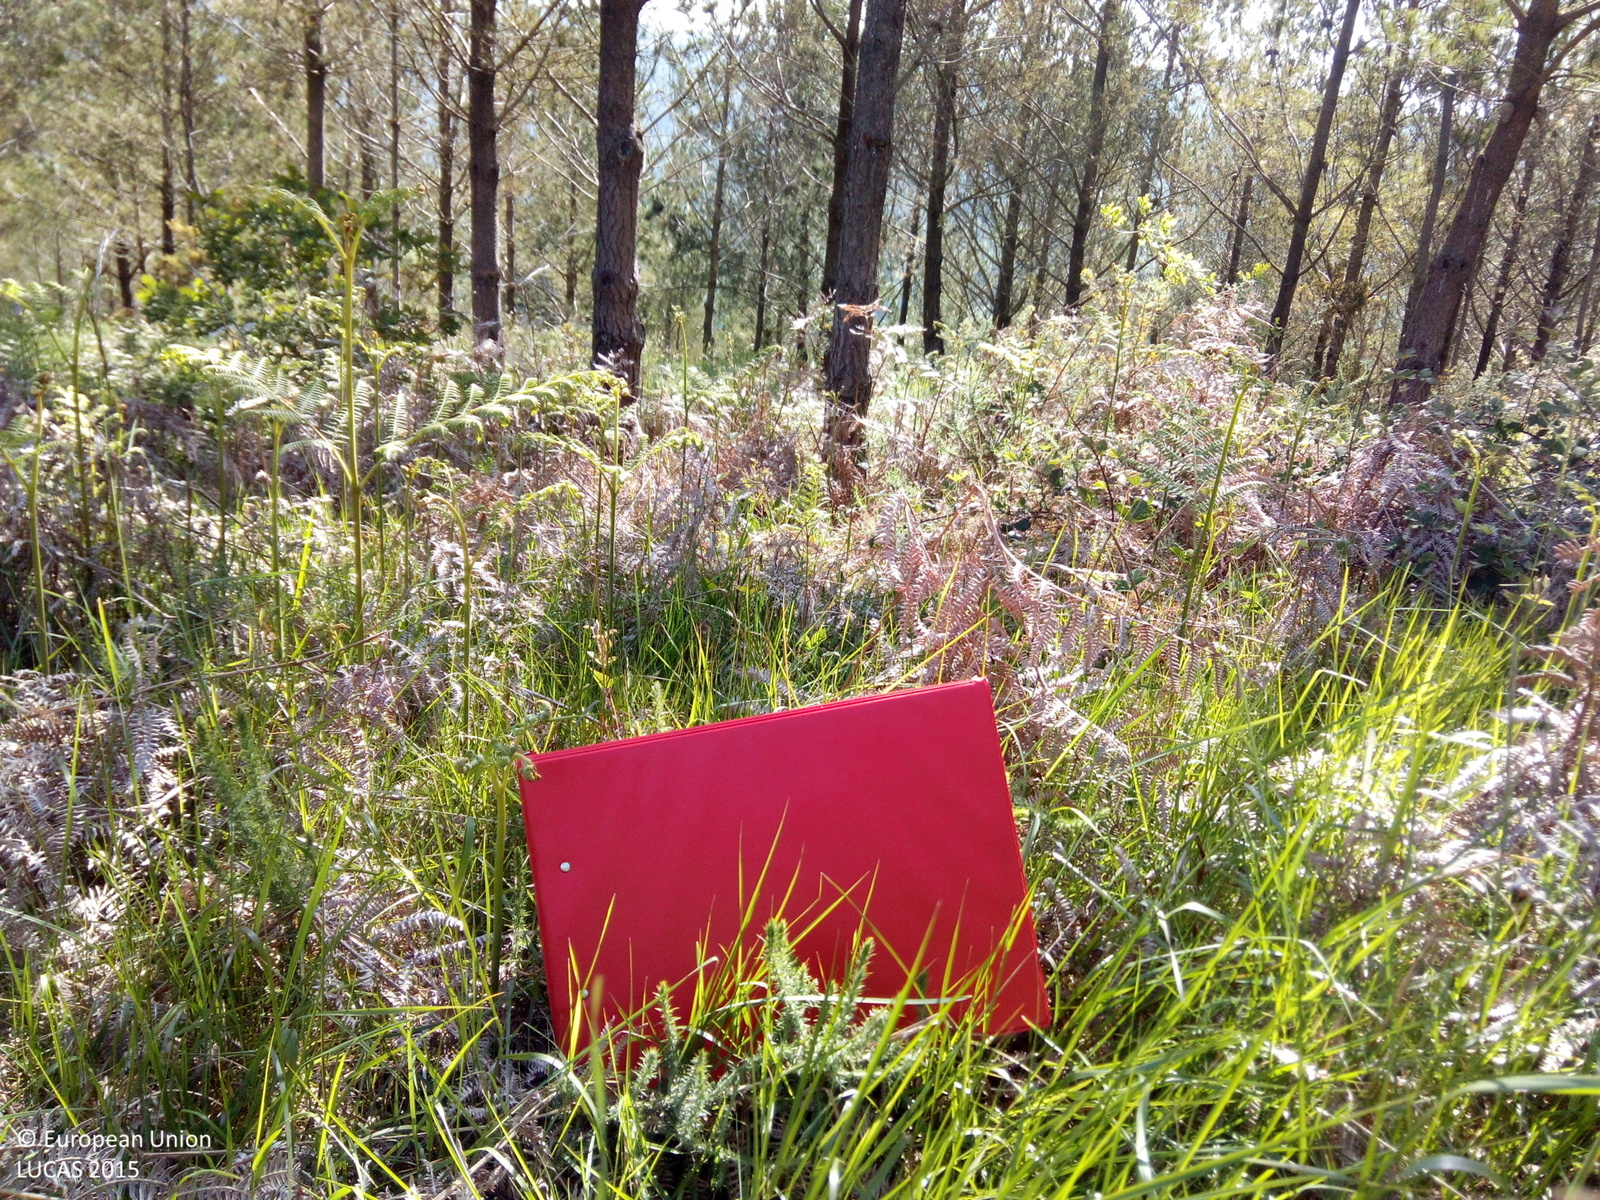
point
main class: Woodland
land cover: Pine dominated coniferous woodland
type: hemiboreal forest and nemoral coniferous forest and mixed broadleaved-coniferous forest
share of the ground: > 75 %
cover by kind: coniferous forest trees 75 %, herbaceous plants 20 %, shrubs 5 %
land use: Forestry
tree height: > 5 m
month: May
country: ES
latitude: 42.6669
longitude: -8.4115
